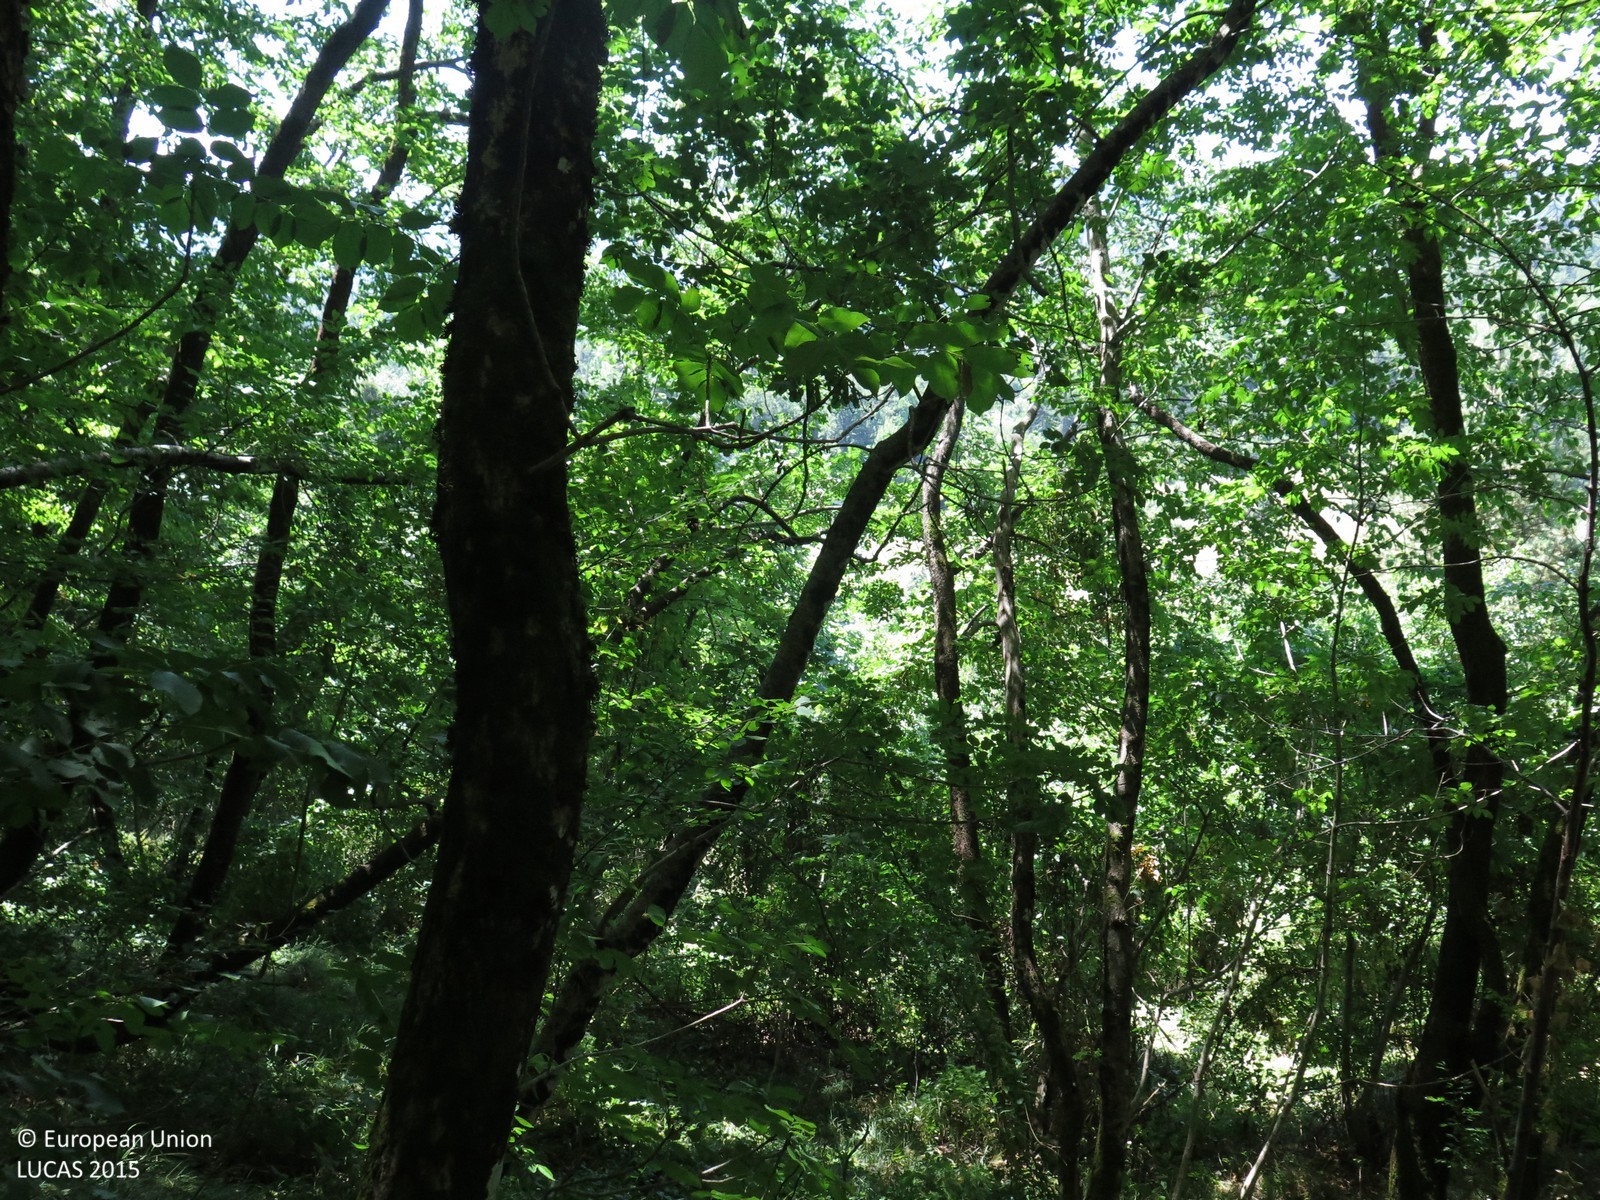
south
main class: Woodland
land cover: Broadleaved woodland
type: beech forest
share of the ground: > 75 %
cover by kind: broadleaved forest trees 90 %, herbaceous plants 5 %, unconsolidated bare surface 5 %
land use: Semi-natural and natural areas not in use
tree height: > 5 m
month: August
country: HR
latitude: 45.2150
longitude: 14.7954
